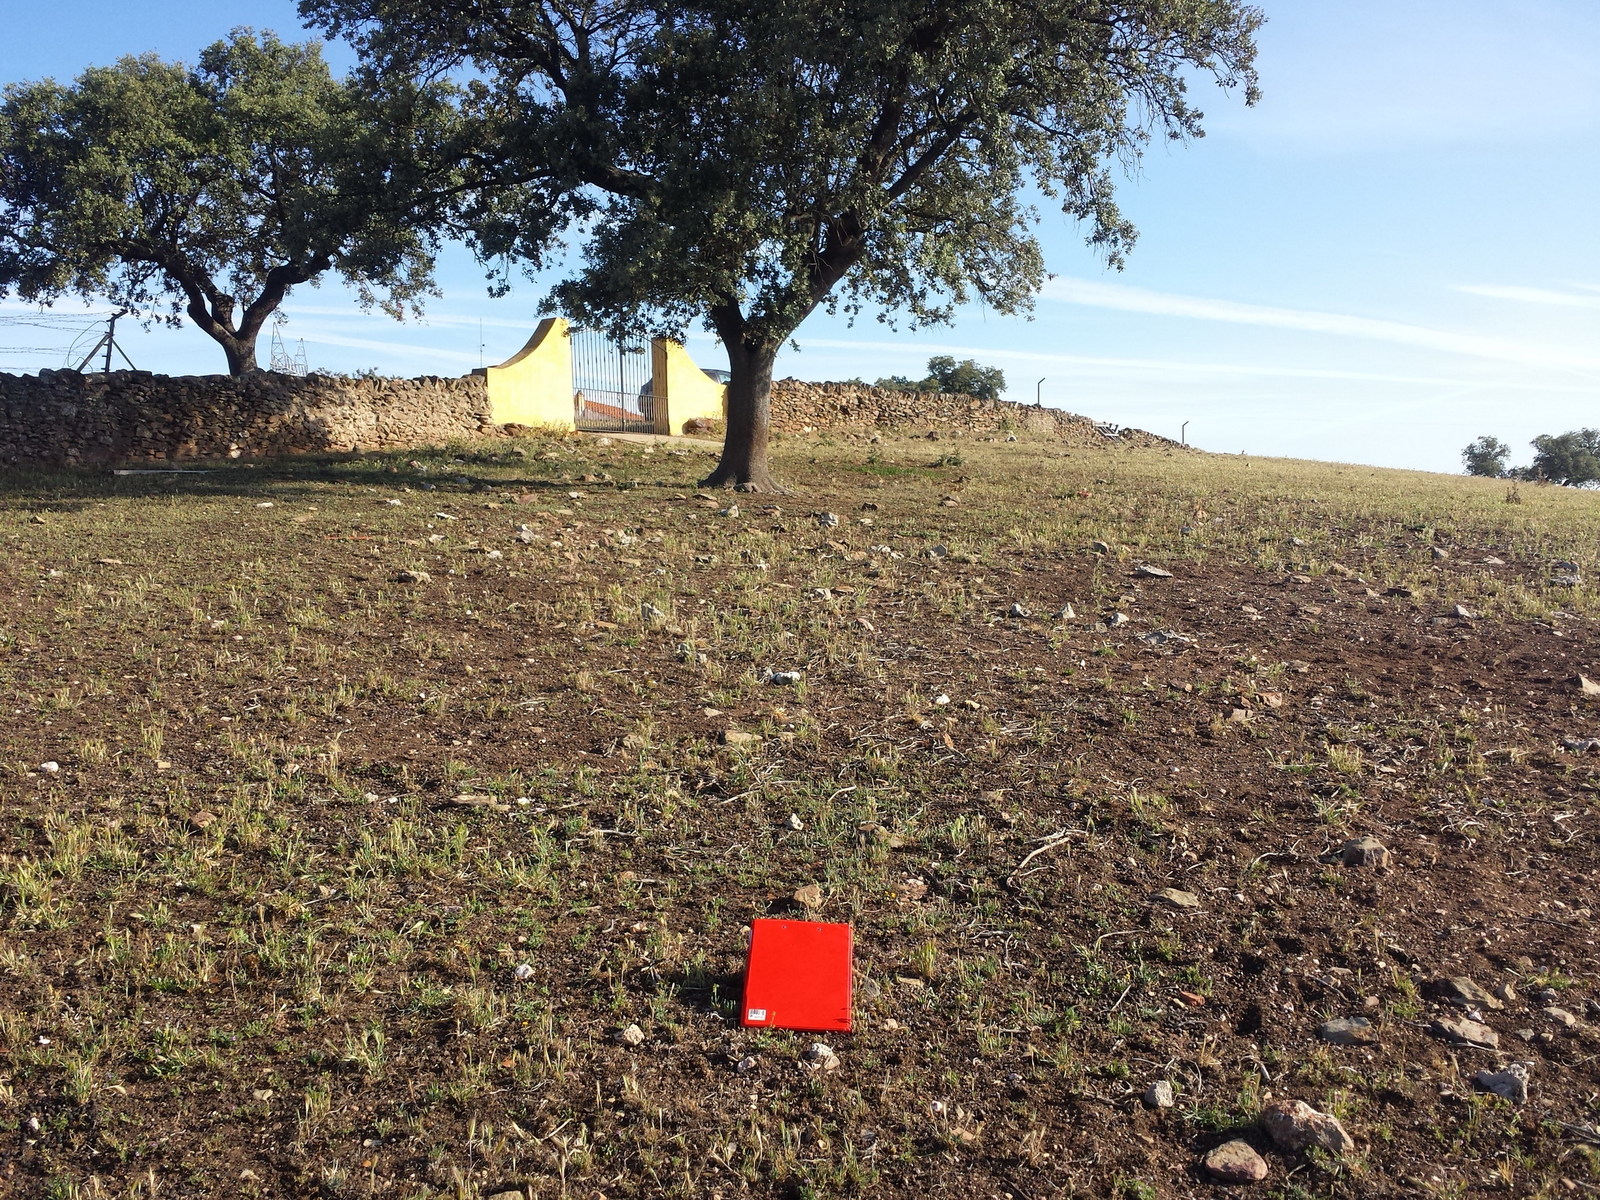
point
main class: Grassland
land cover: Grassland with sparse tree/shrub cover
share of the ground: > 75 %
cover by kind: herbaceous plants 90 %, broadleaved forest trees 5 %
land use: Agriculture (excluding fallow land and kitchen gardens)
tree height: > 5 m
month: May
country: ES
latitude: 39.6384
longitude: -7.2058
